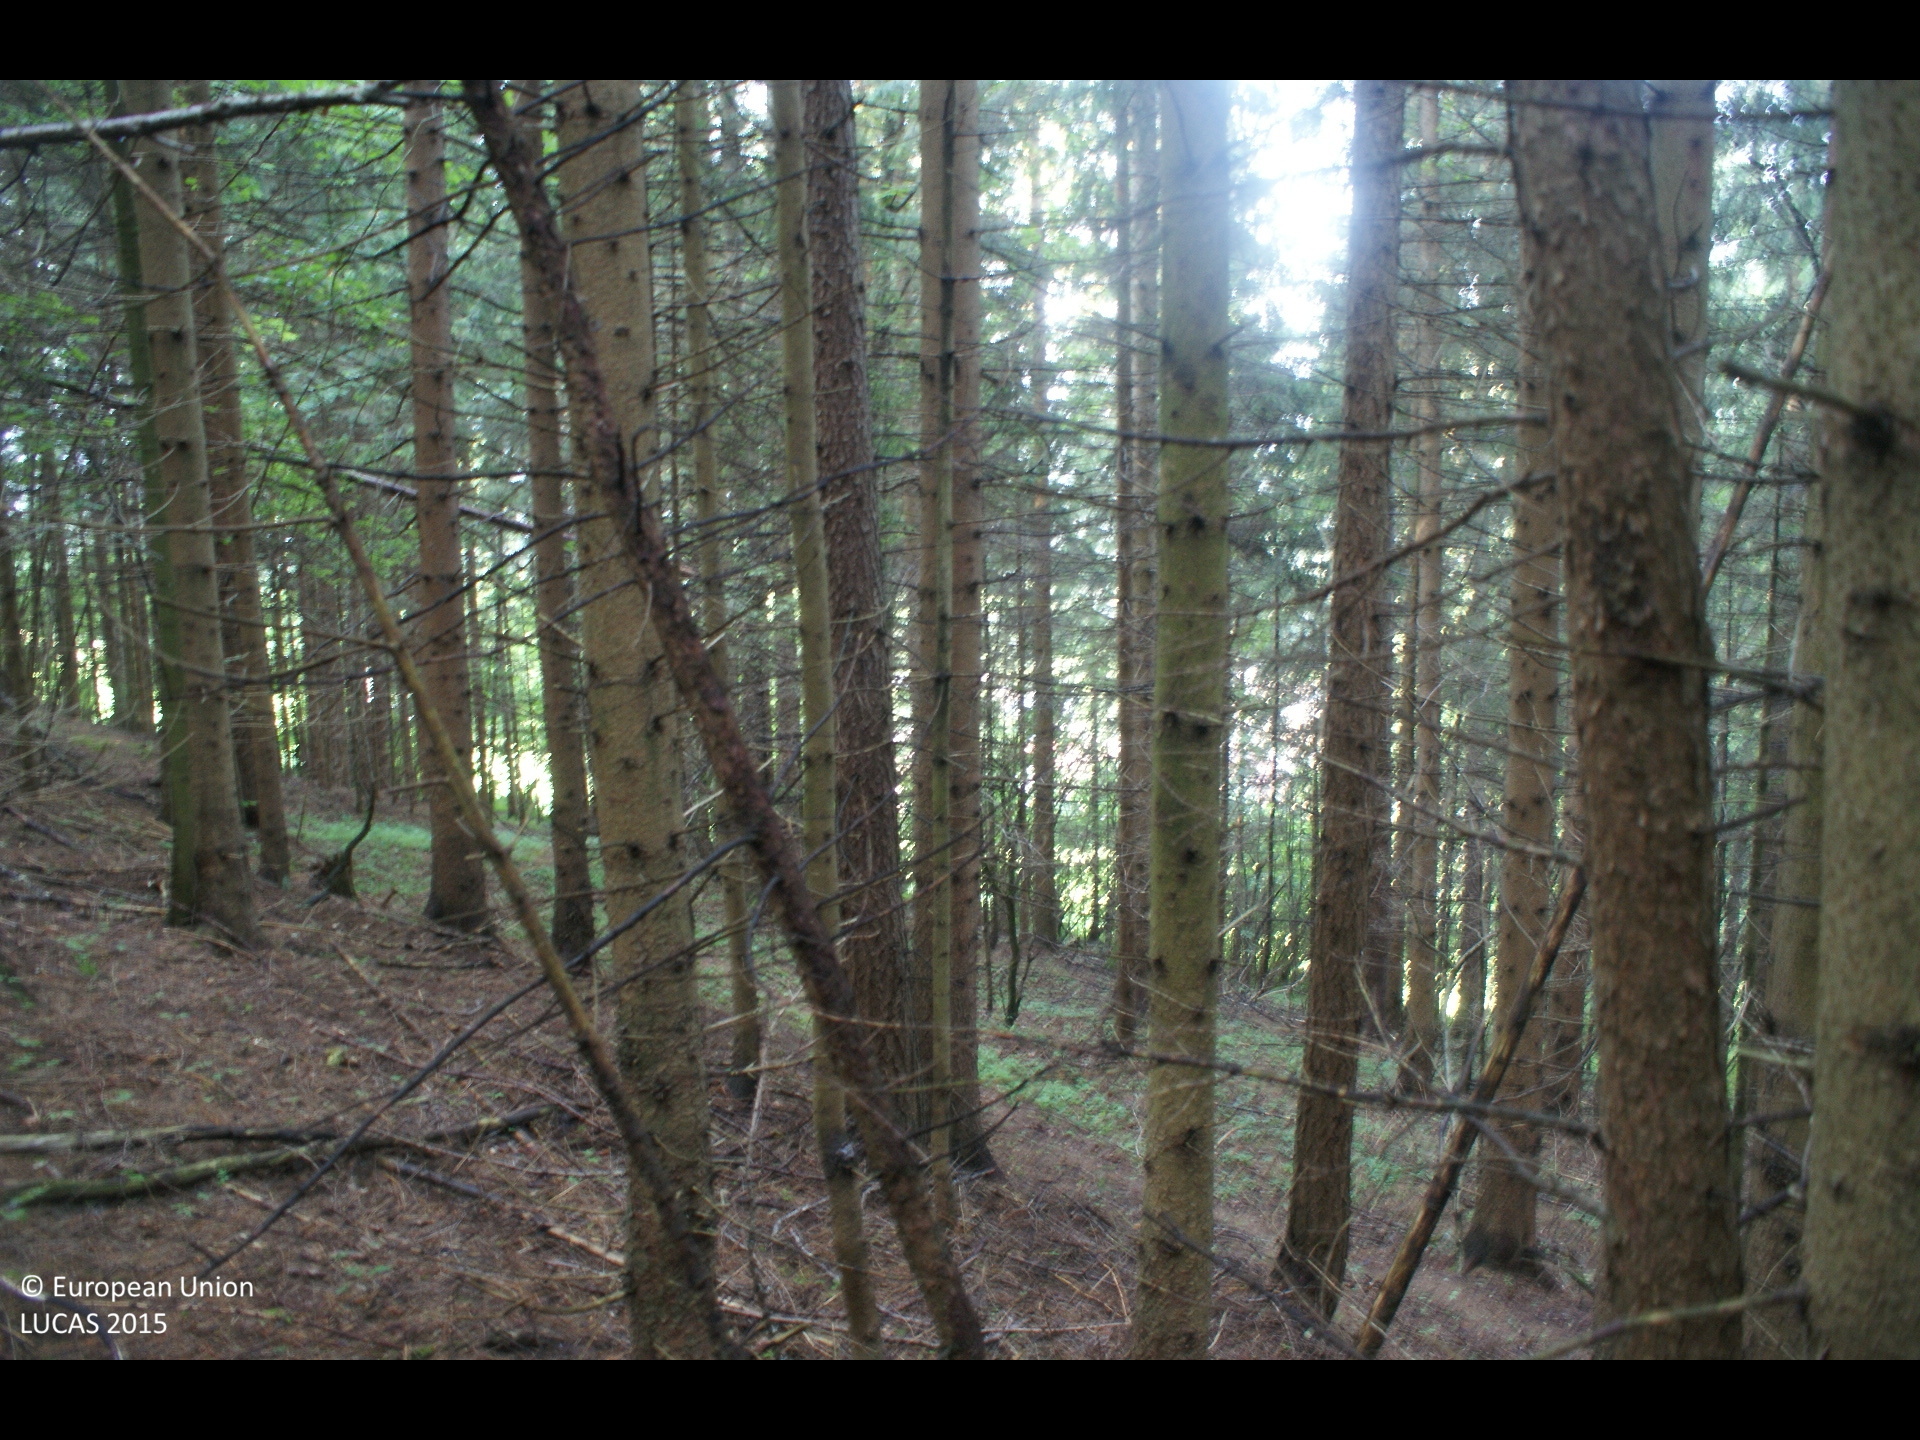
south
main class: Woodland
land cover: Spruce dominated coniferous woodland
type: alpine coniferous forest
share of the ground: > 75 %
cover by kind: coniferous forest trees 90 %, unconsolidated bare surface 10 %
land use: Forestry
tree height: > 5 m
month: July
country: AT
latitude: 47.7702
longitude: 15.3252
